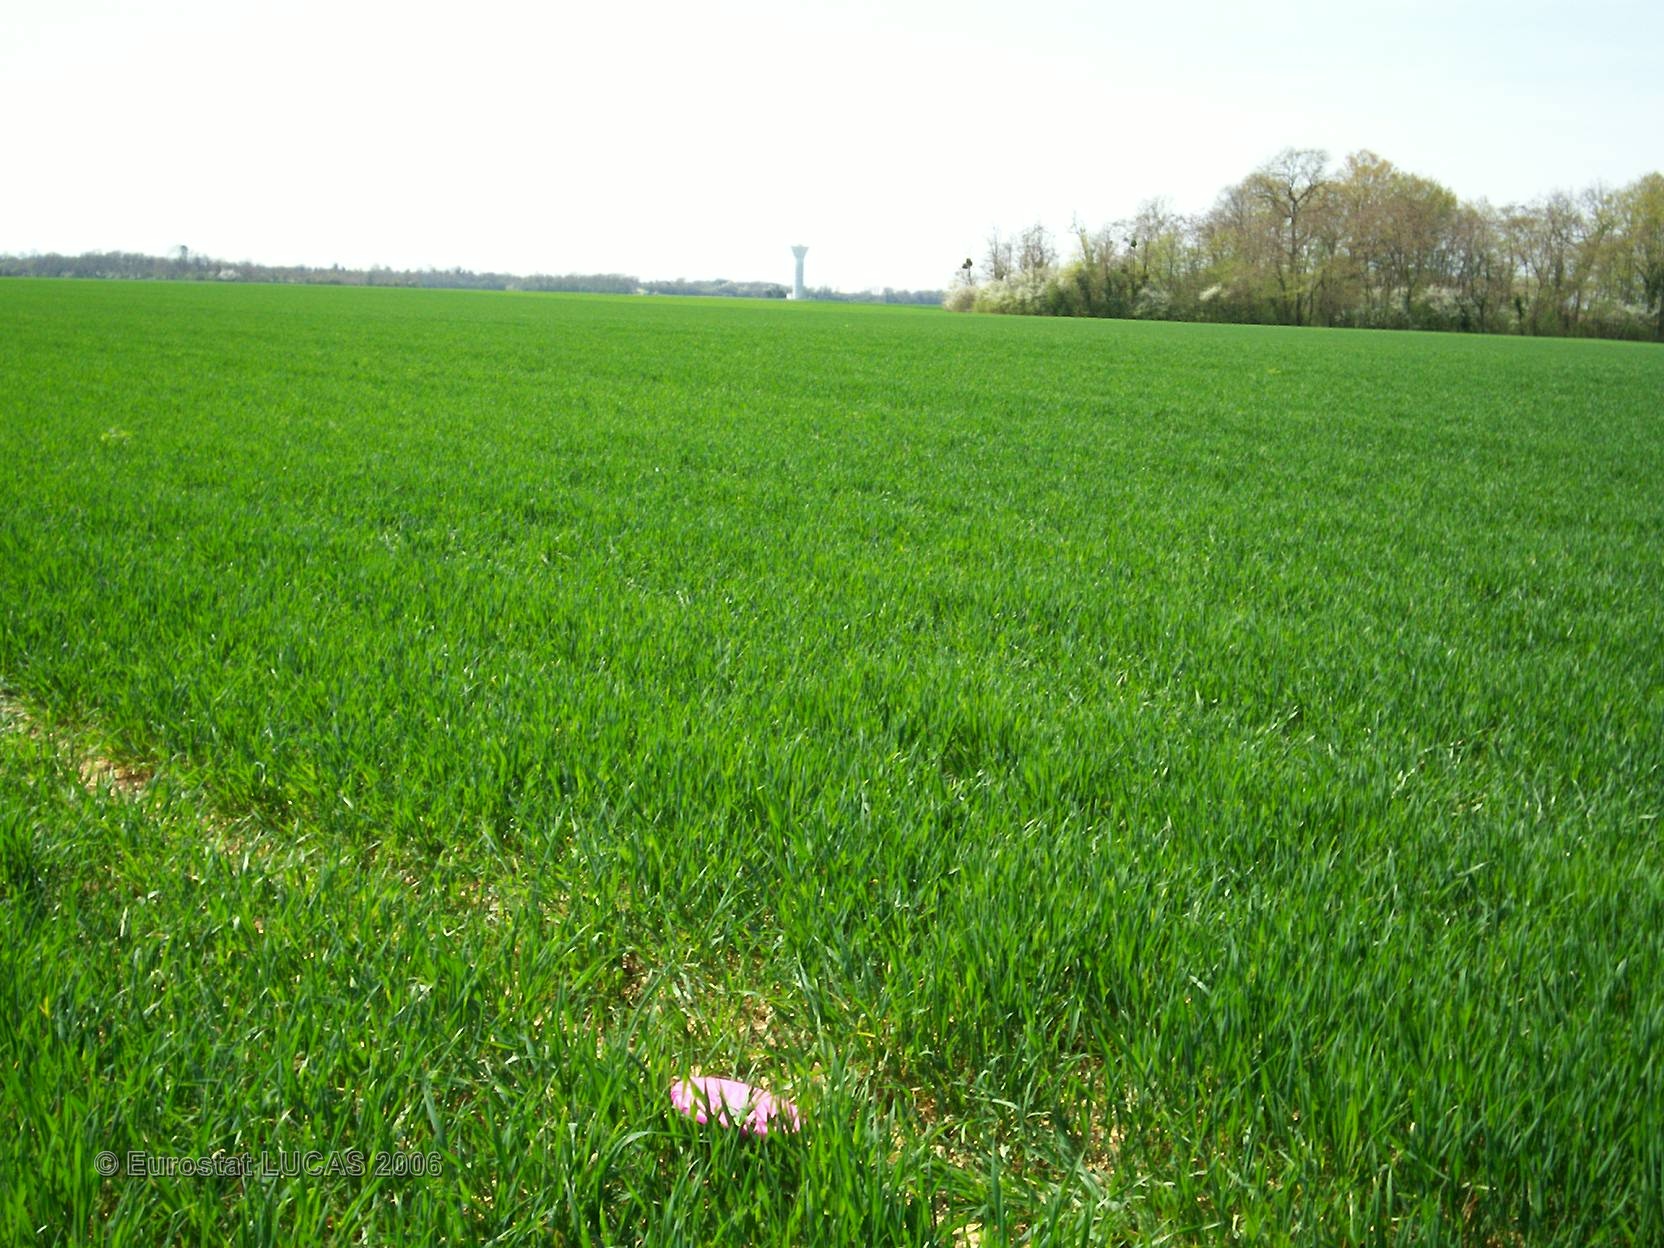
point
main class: Cropland
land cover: Common wheat
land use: Agriculture (excluding fallow land and kitchen gardens)
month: April
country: FR
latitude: 48.4440
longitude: 4.4409
